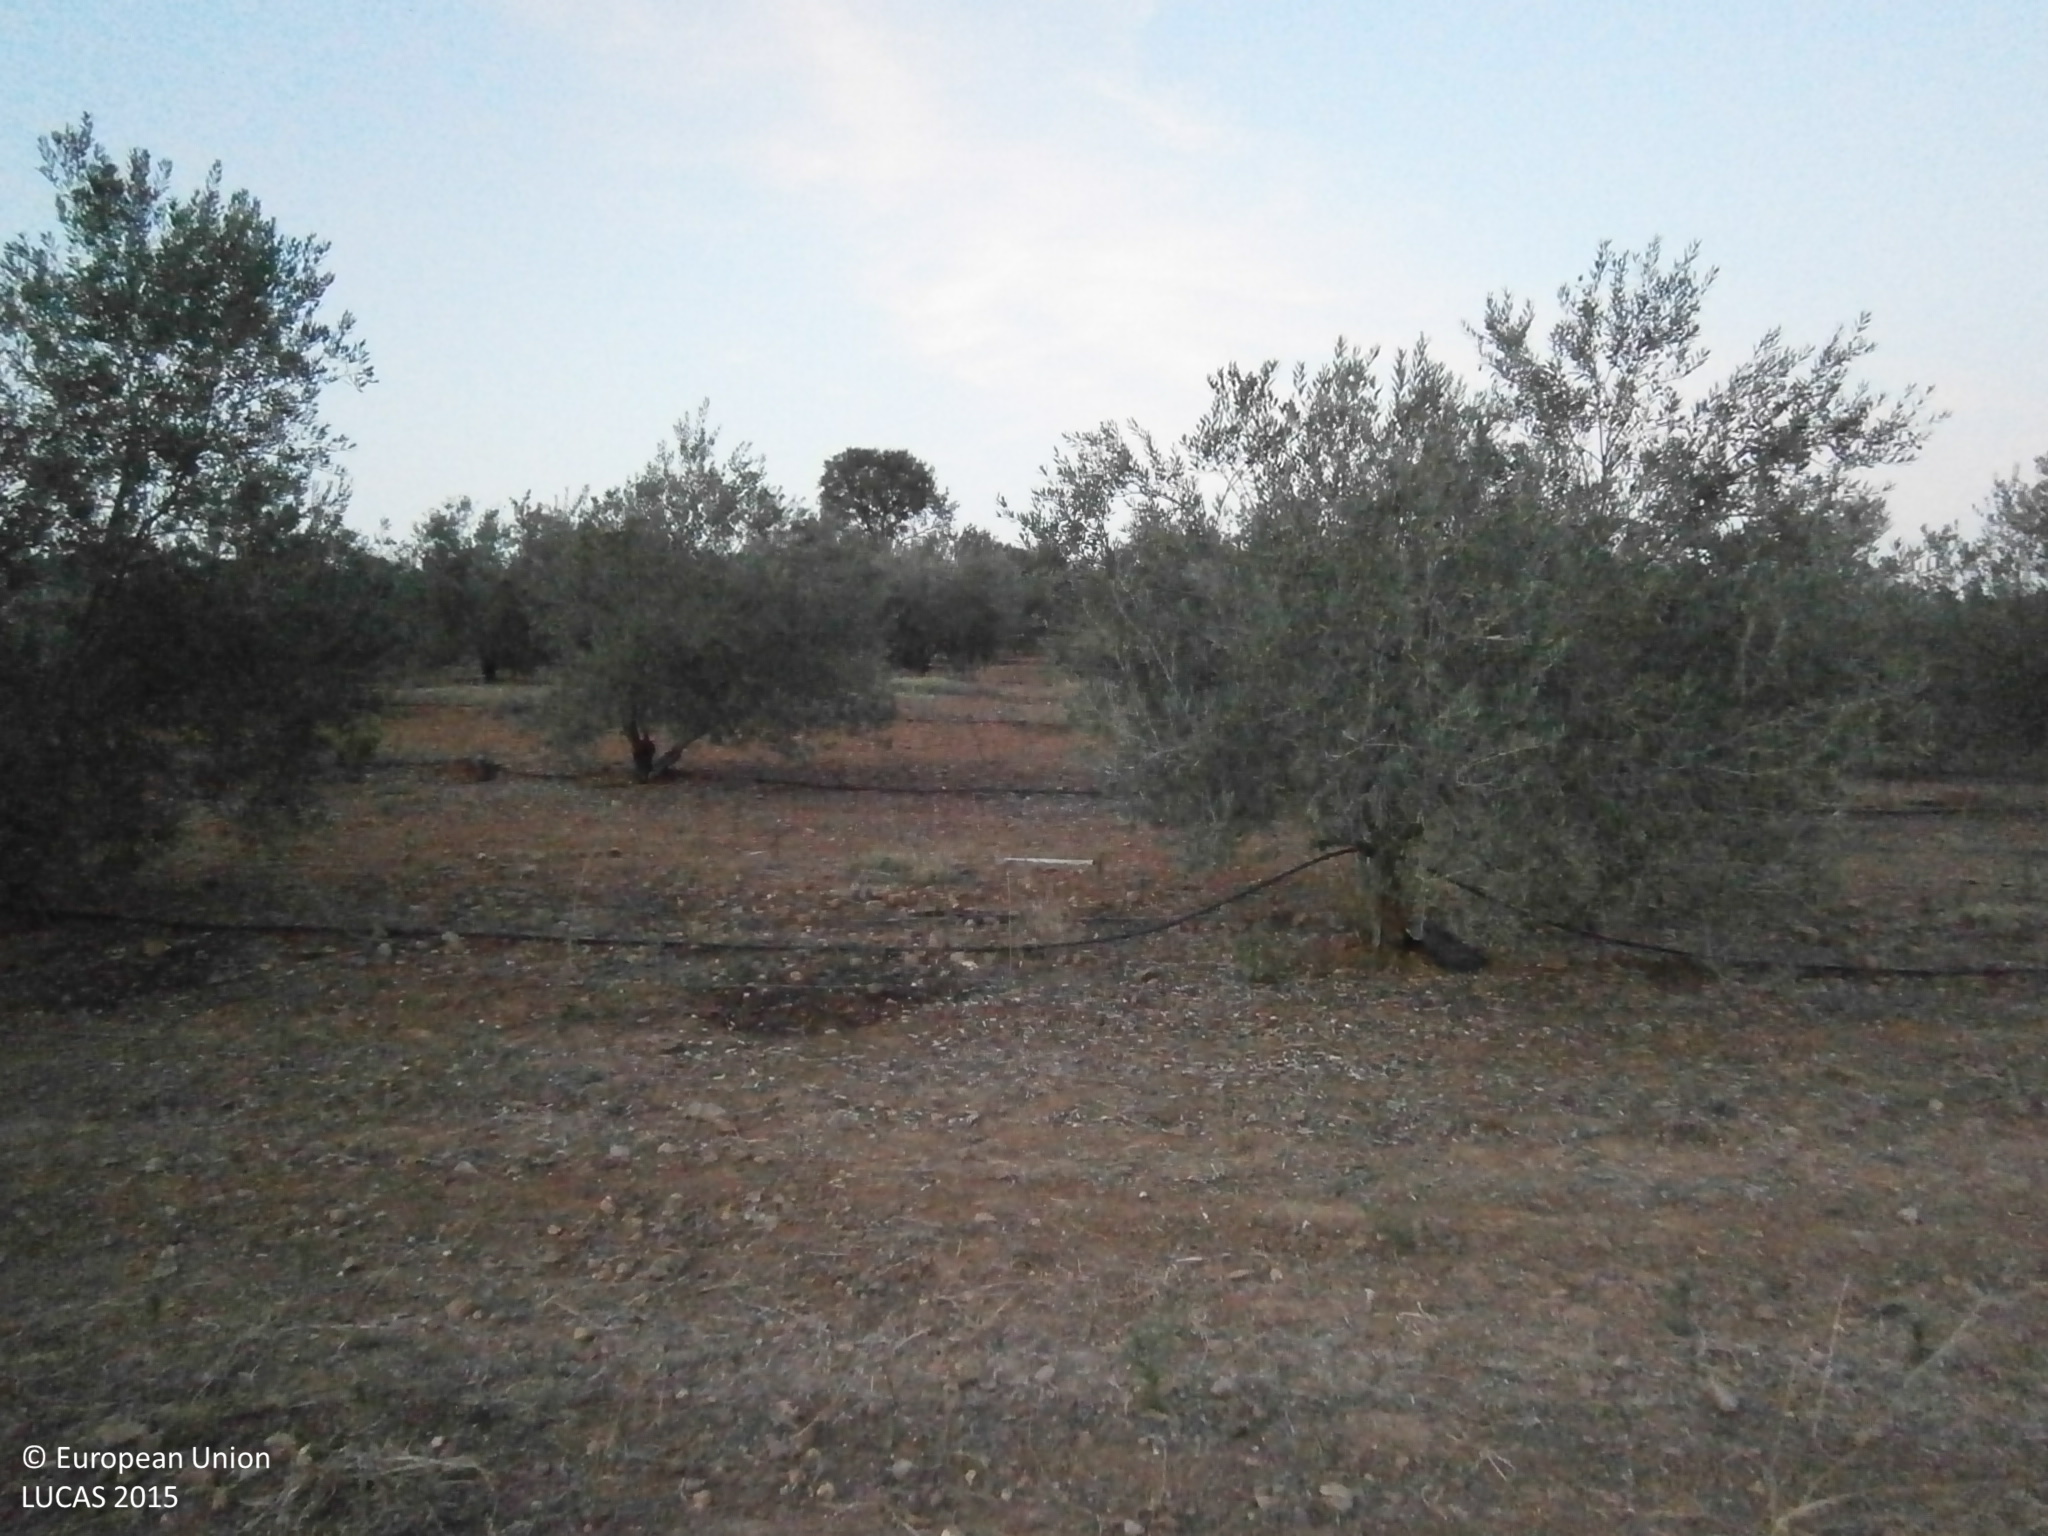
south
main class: Cropland
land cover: Olive groves
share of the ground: 25 - 50 %
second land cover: Spontaneously vegetated surfaces
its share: 25 - 50 %
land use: Agriculture (excluding fallow land and kitchen gardens)
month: July
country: ES
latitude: 38.8035
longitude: -6.8194
